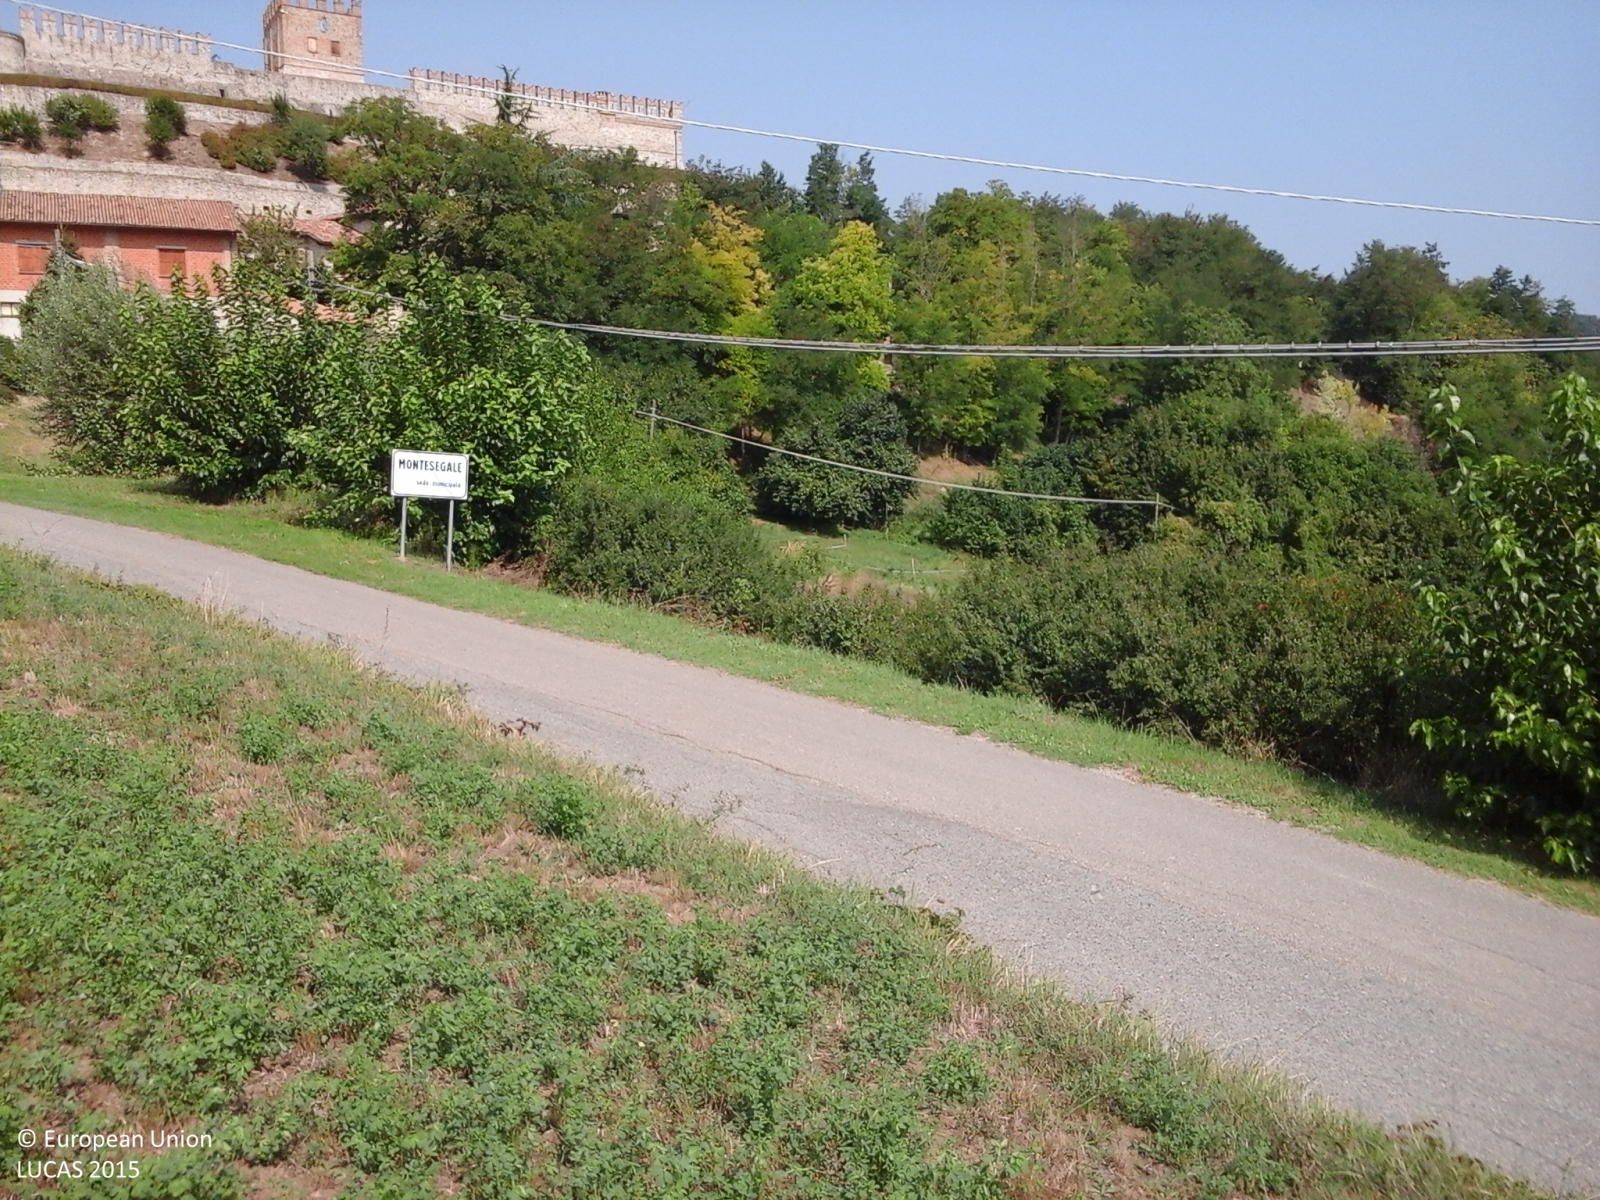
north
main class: Cropland
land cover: Lucerne
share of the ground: > 75 %
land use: Agriculture (excluding fallow land and kitchen gardens)
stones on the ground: < 10 %
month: August
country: IT
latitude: 44.9059
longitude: 9.1278
